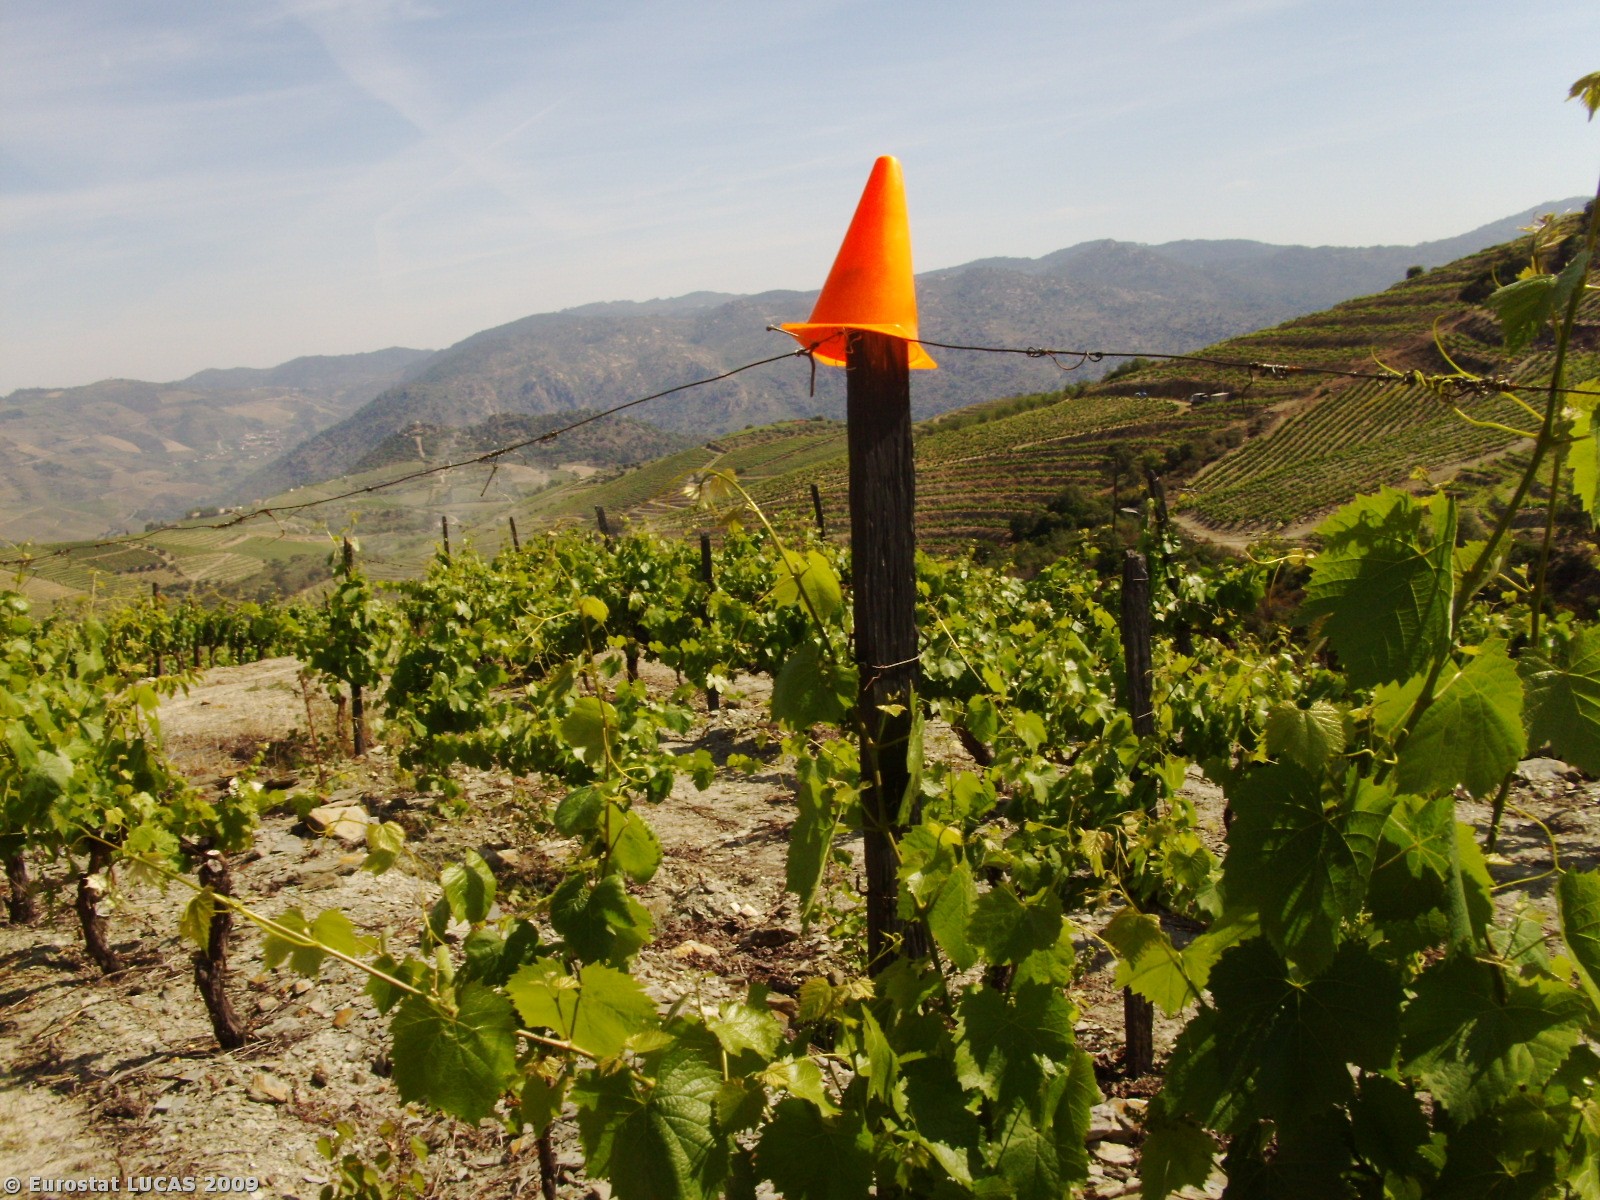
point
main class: Cropland
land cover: Vineyards
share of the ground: 10 - 25 %
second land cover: Bare land
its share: > 75 %
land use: Agriculture (excluding fallow land and kitchen gardens)
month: May
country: PT
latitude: 41.1686
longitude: -7.4141
